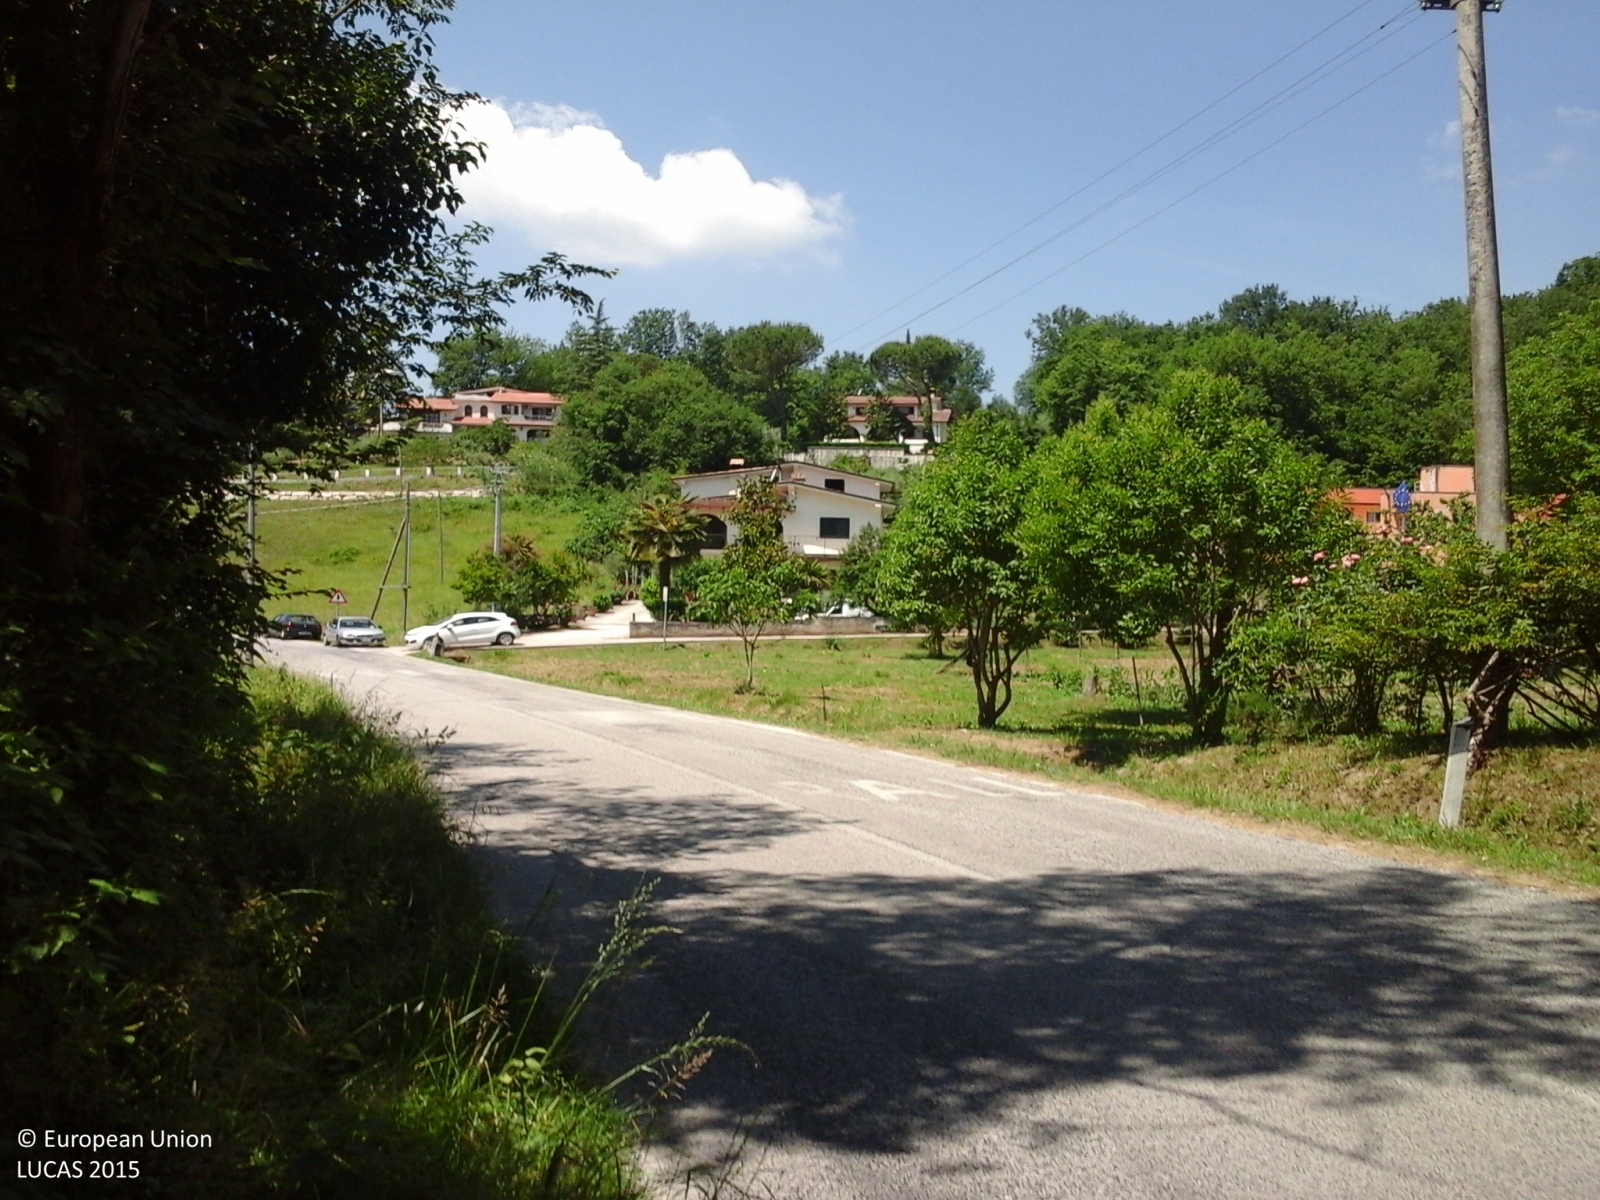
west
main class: Woodland
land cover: Broadleaved woodland
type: thermophilous deciduous forest
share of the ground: 50 - 75 %
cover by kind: broadleaved forest trees 95 %, herbaceous plants 5 %
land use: Forestry
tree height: > 5 m
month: June
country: IT
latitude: 41.6452
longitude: 13.7203
